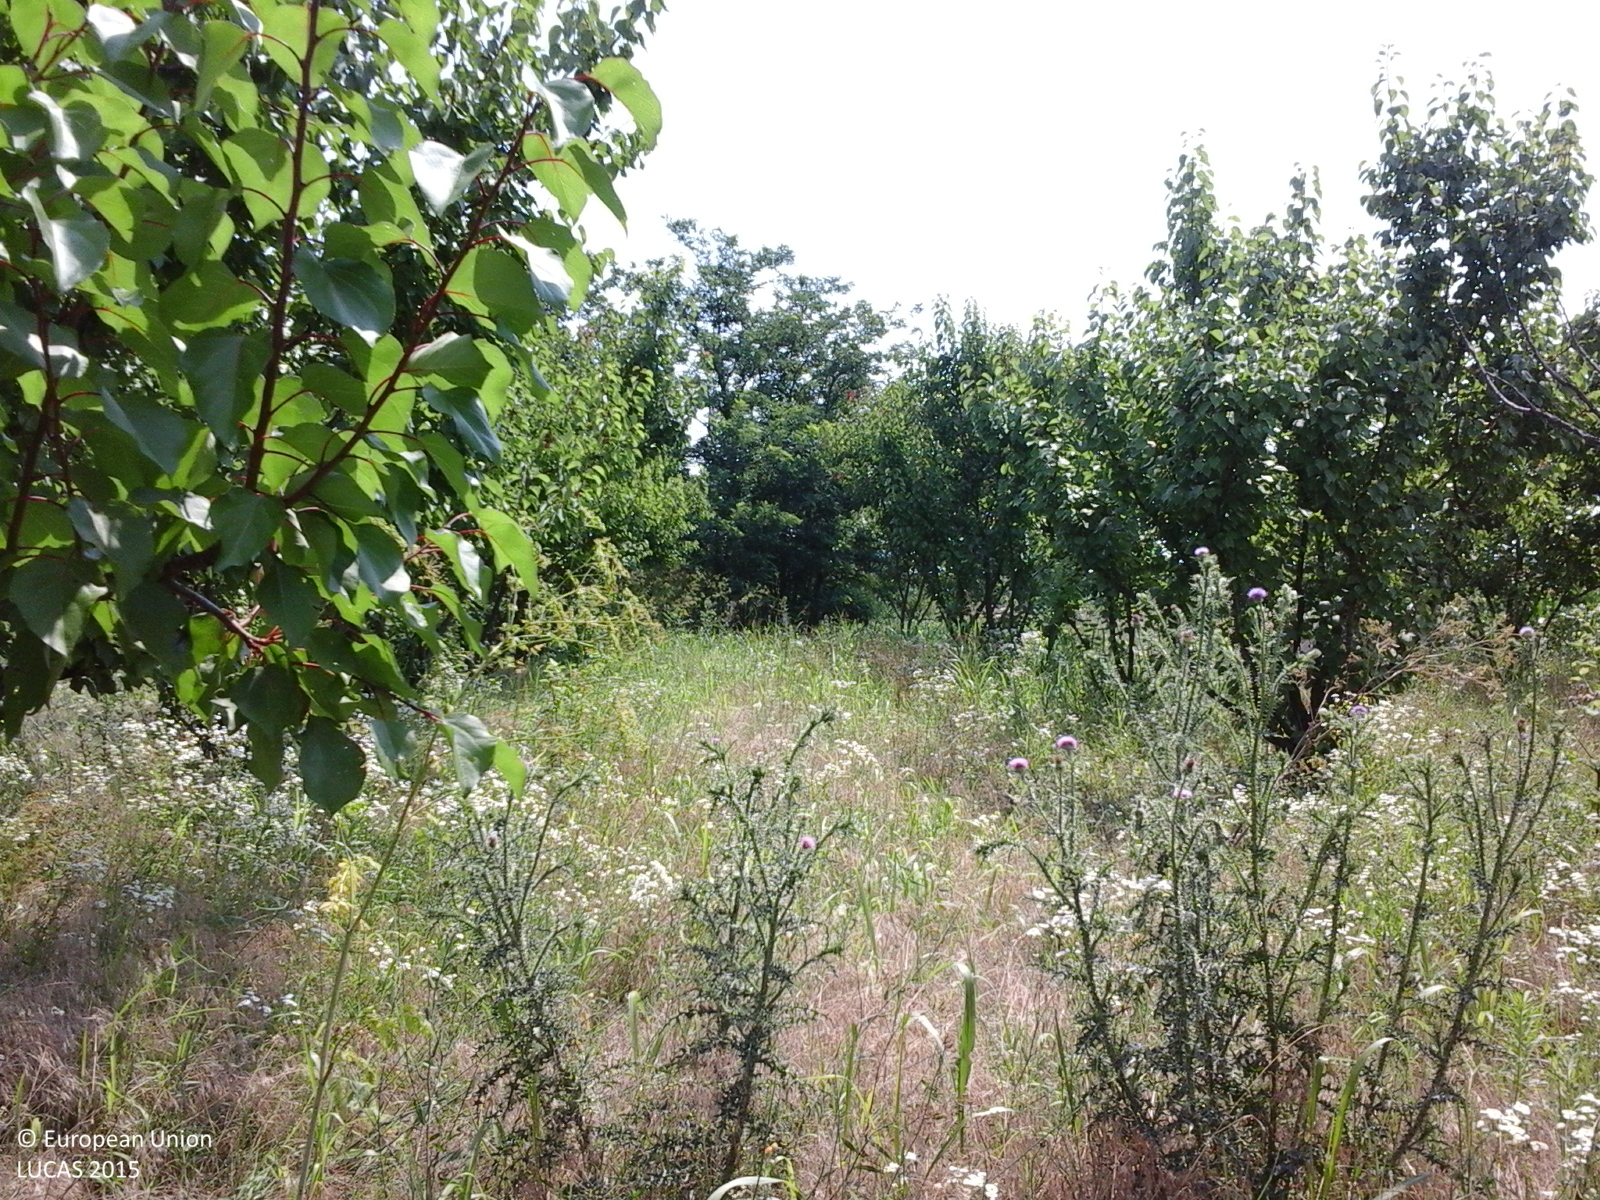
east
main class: Cropland
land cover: Other fruit trees and berries
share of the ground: 50 - 75 %
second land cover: Grassland without tree/shrub cover
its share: > 75 %
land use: Agriculture (excluding fallow land and kitchen gardens)
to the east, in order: Other fruit trees and berries; Grassland without tree/shrub cover; Single bushes/trees; Grass margins; Tracks; Grass margins; Maize; Tracks; Common wheat
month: July
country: RO
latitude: 43.8422
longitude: 25.4703
